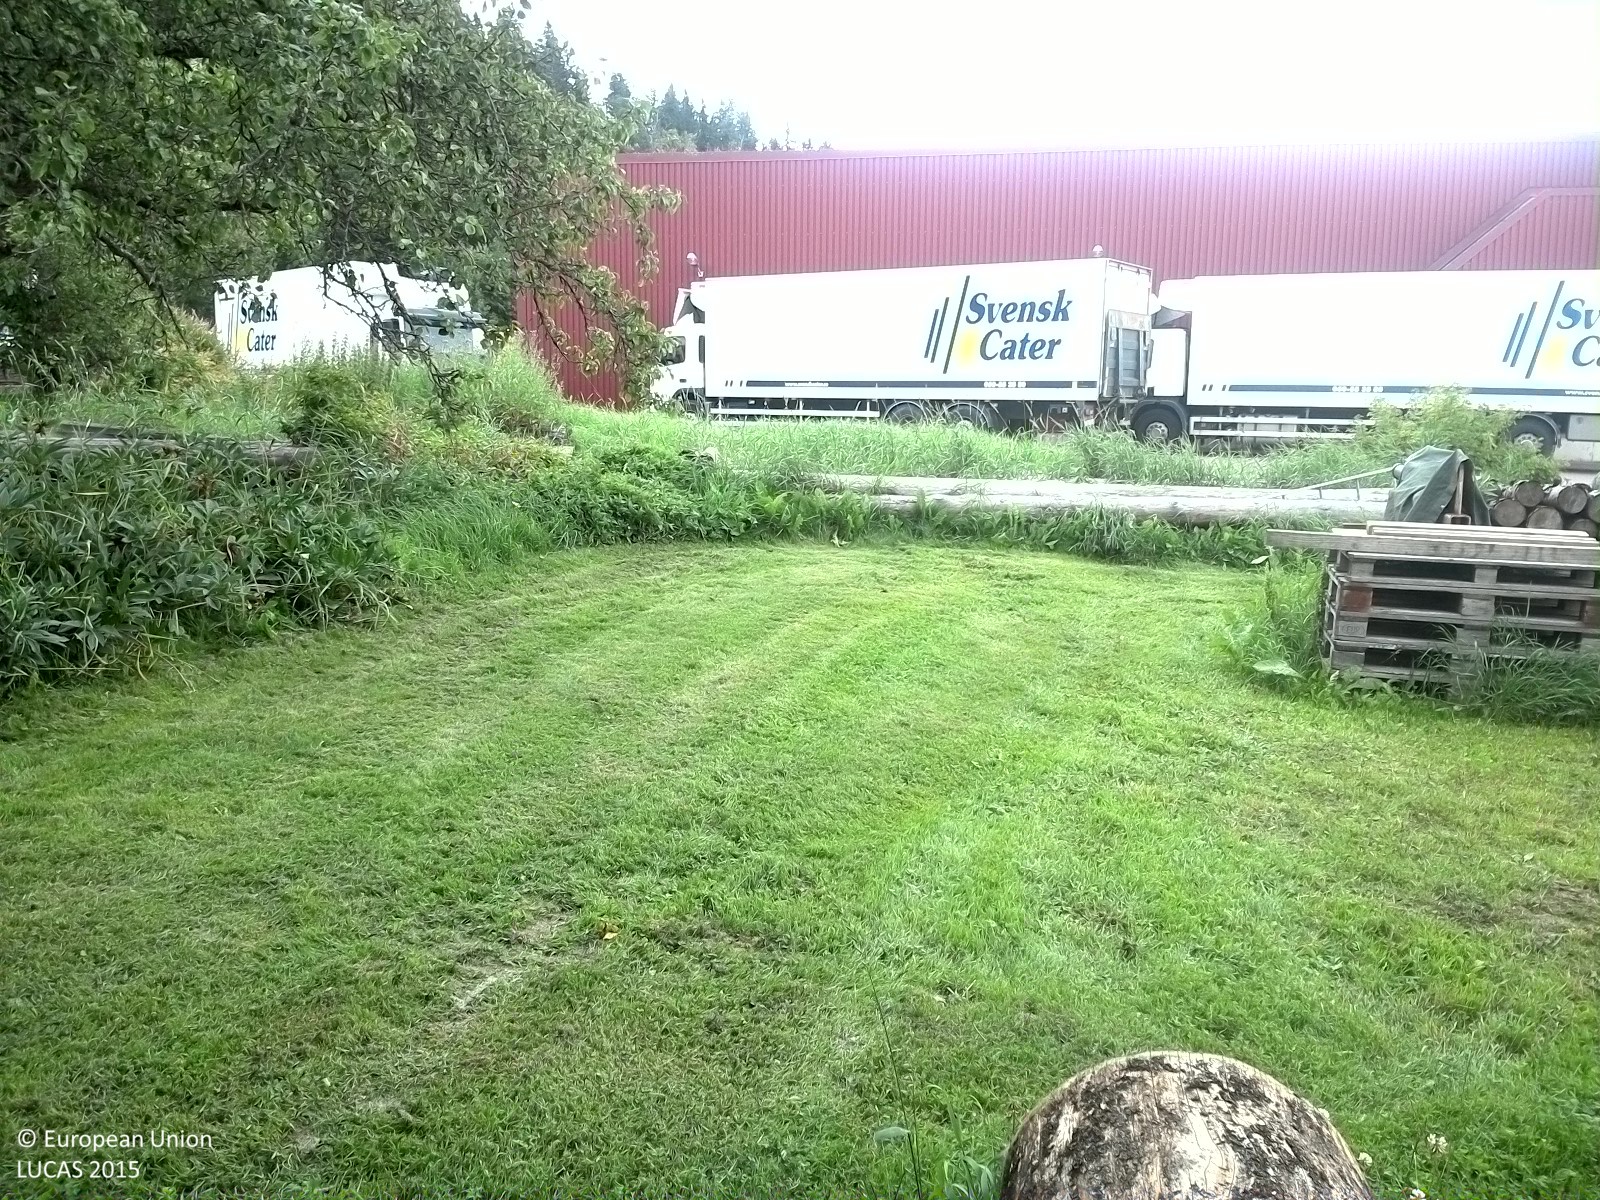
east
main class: Grassland
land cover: Grassland without tree/shrub cover
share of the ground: > 75 %
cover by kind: herbaceous plants 100 %
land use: Residential
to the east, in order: Grassland without tree/shrub cover; Artificial constructions in urban areas; Broadleaved woodland; Electric lines; Spruce dominated coniferous woodland; Other mixed woodland
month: August
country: SE
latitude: 62.4144
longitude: 17.3555
